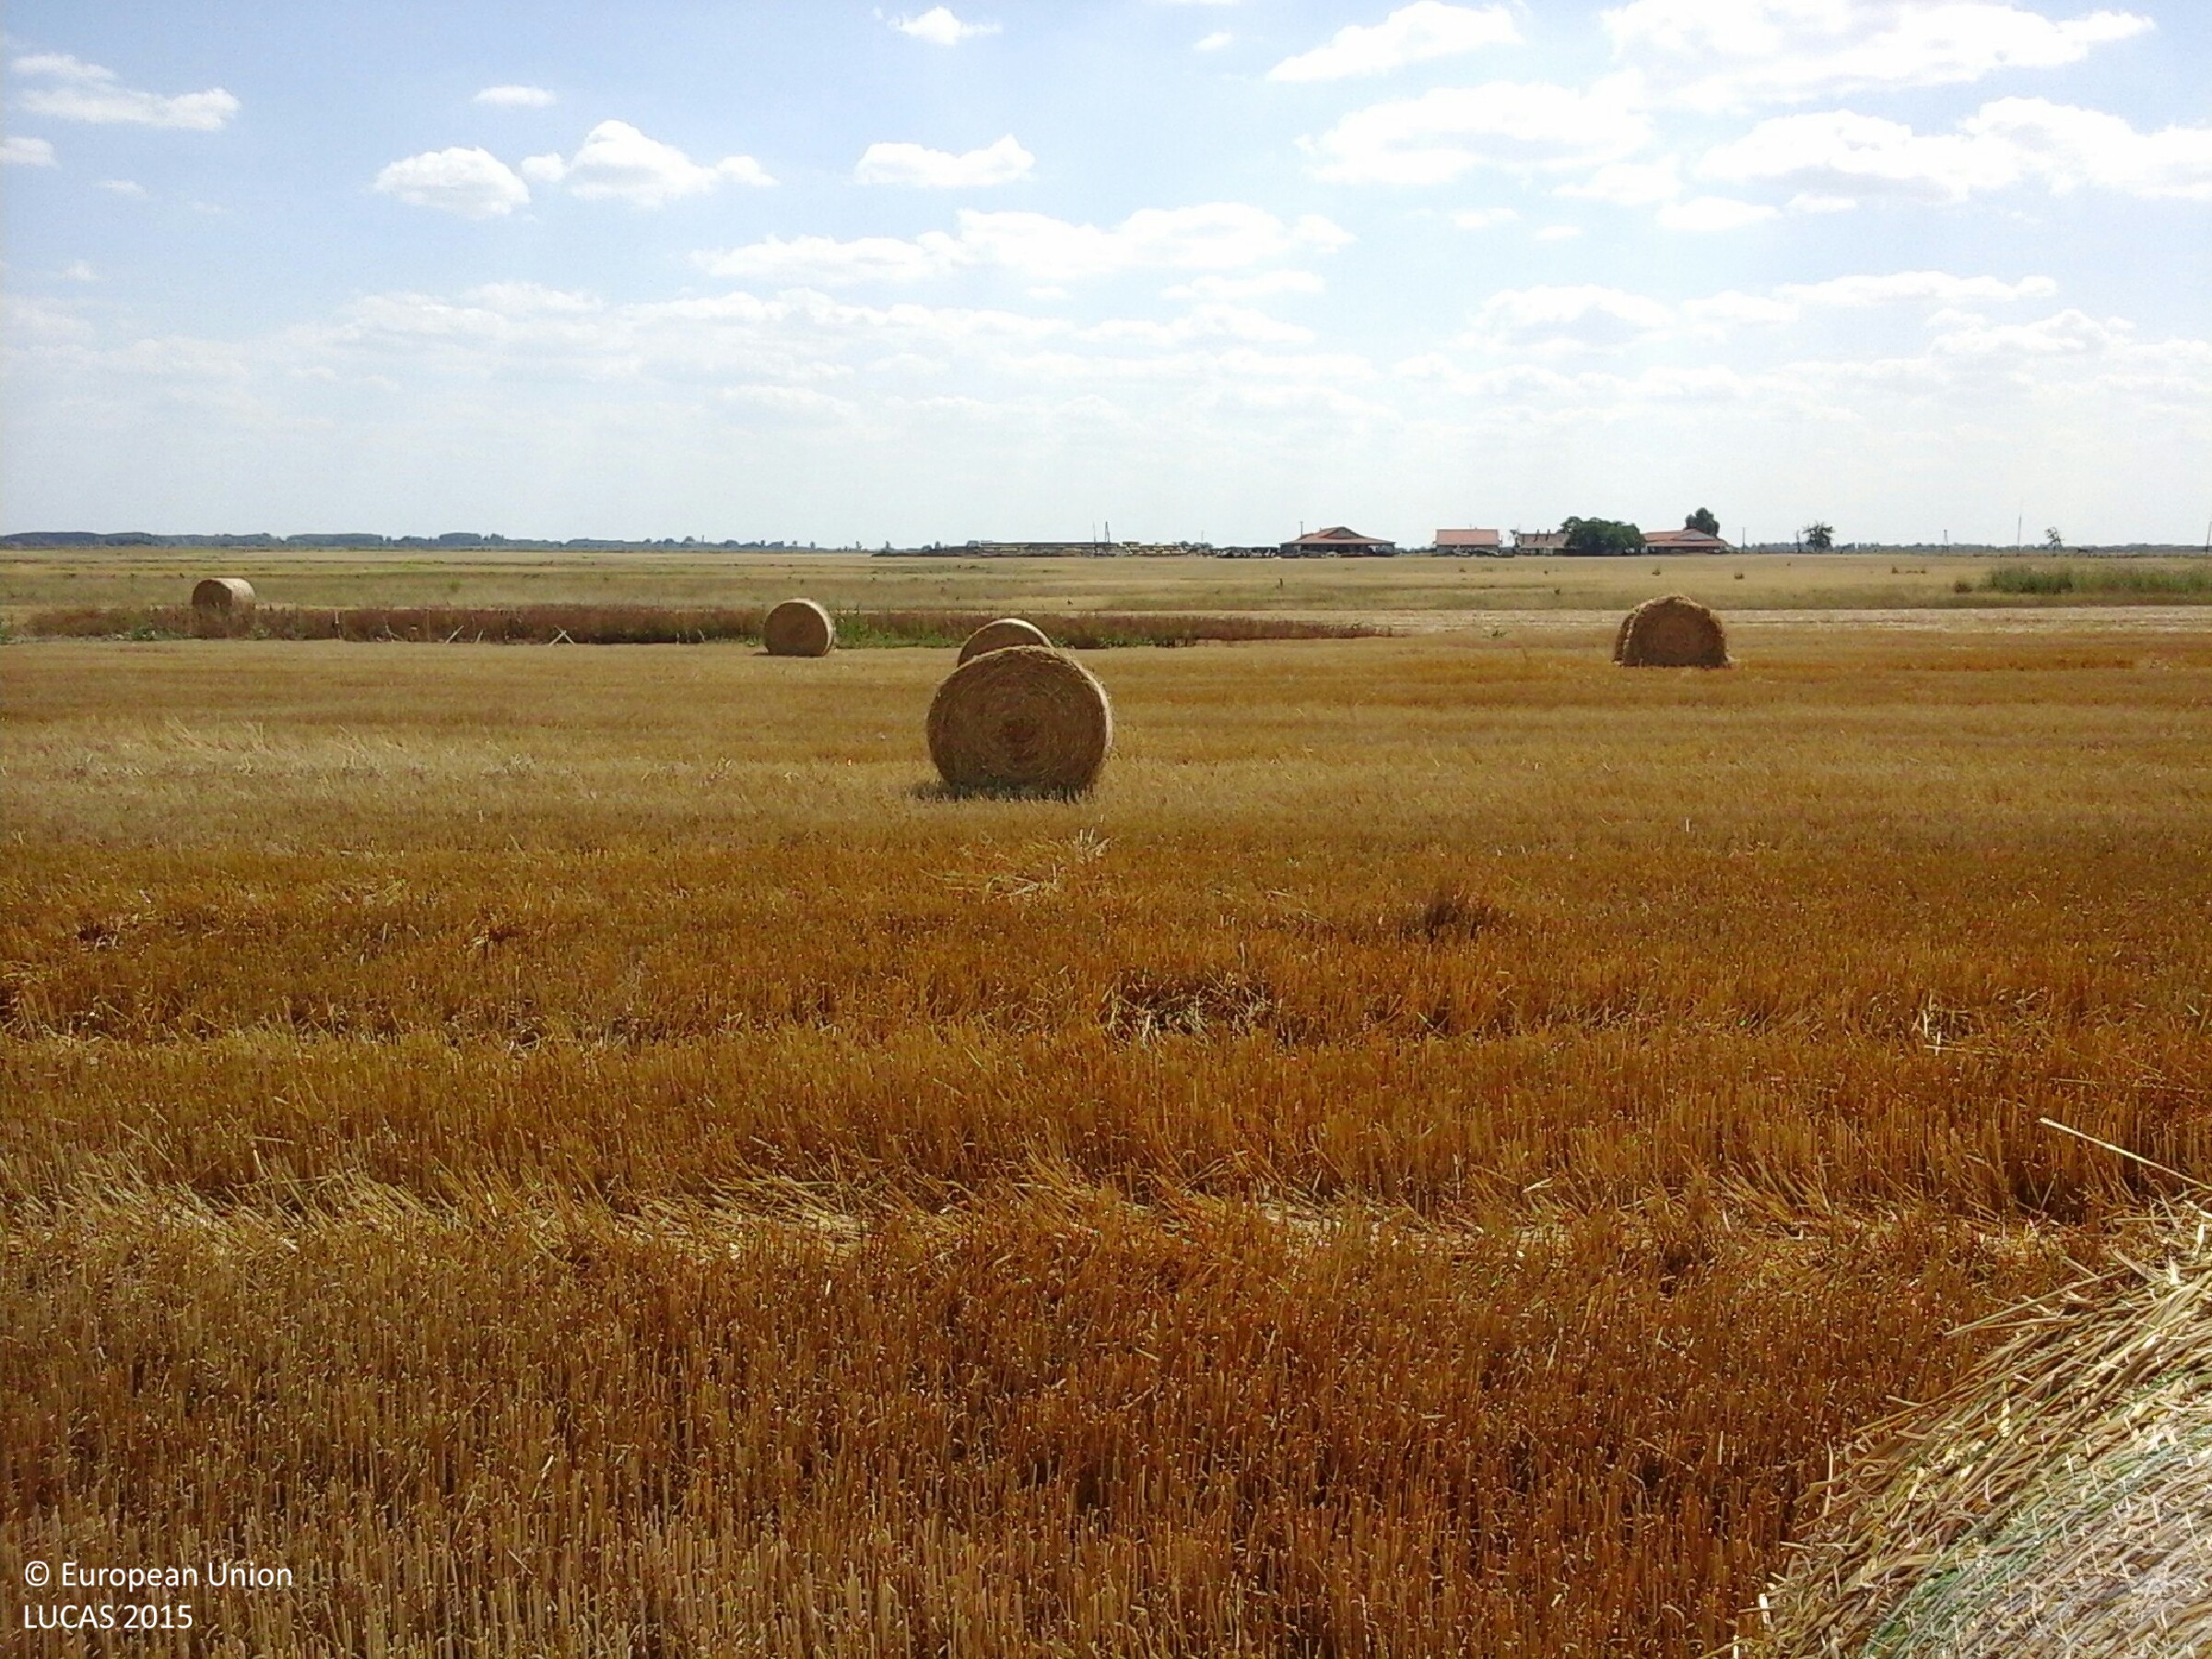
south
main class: Cropland
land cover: Common wheat
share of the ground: 50 - 75 %
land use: Agriculture (excluding fallow land and kitchen gardens)
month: July
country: HU
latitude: 47.6574
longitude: 20.5914
